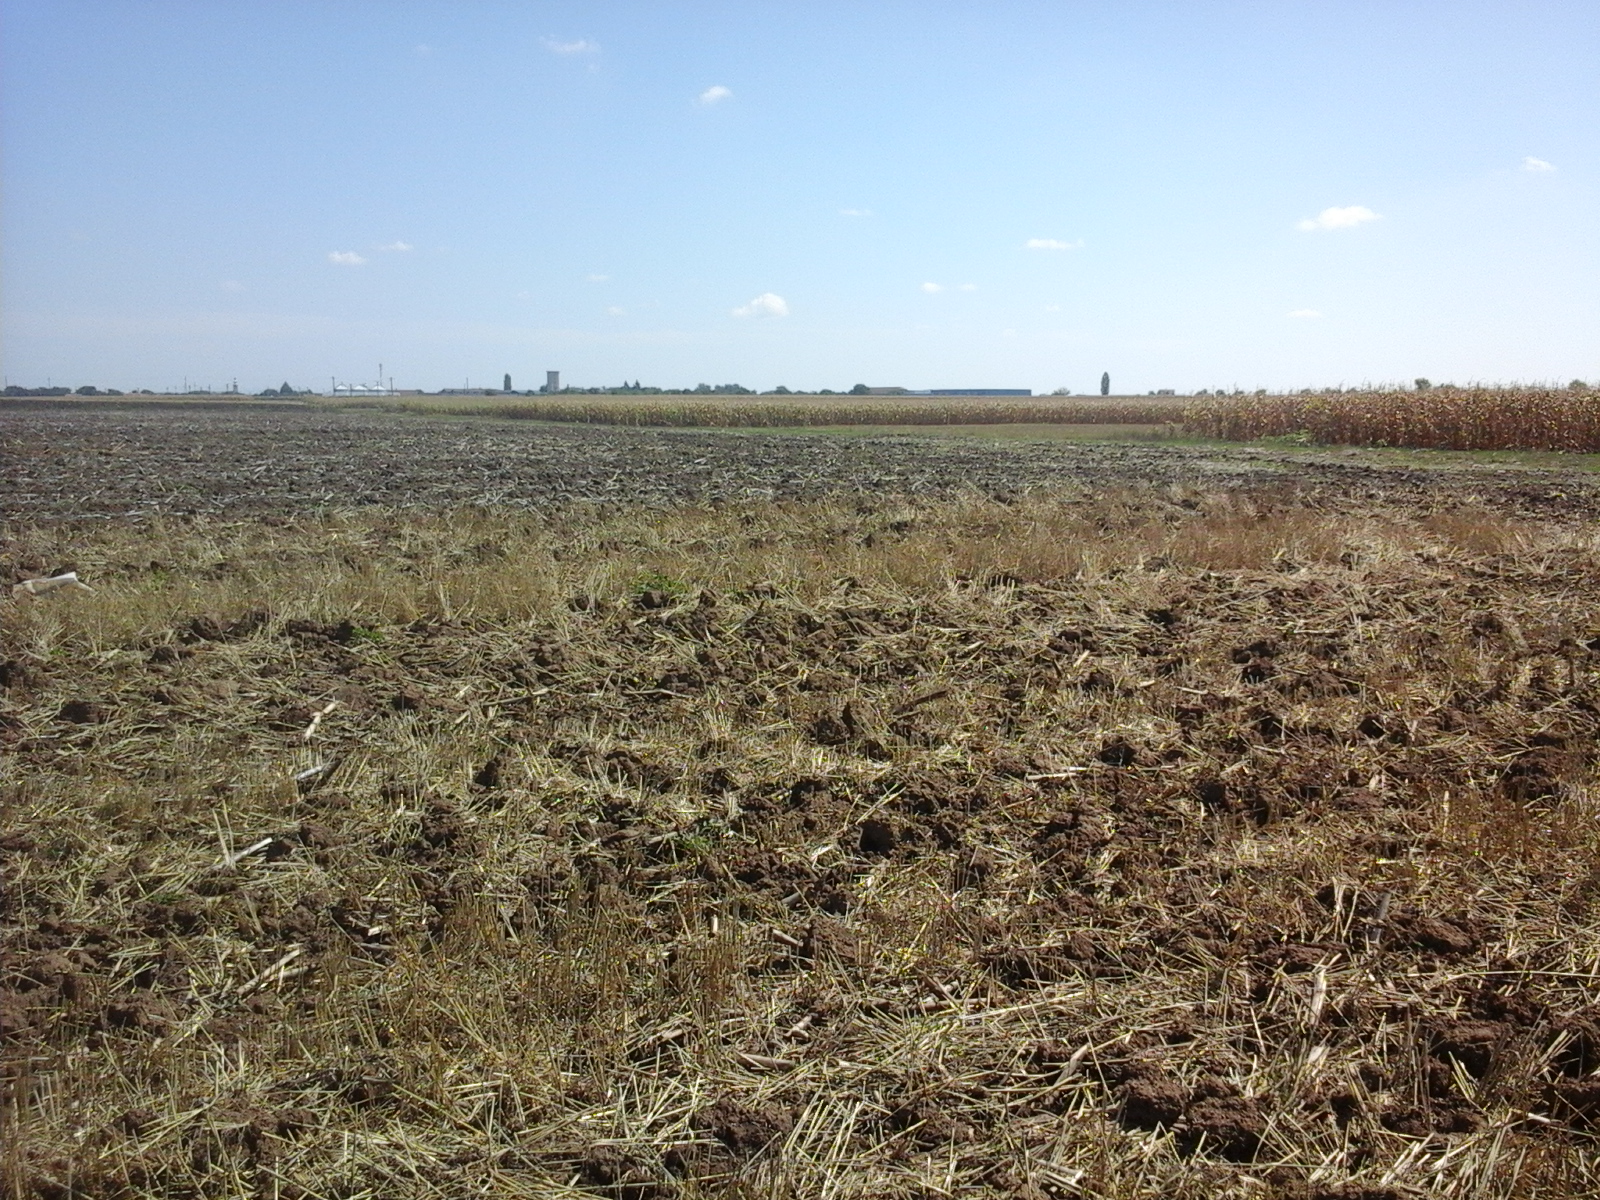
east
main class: Cropland
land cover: Common wheat
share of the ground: 50 - 75 %
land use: Agriculture (excluding fallow land and kitchen gardens)
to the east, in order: Common wheat; Rape and turnip rape; Grass margins; Tracks; Grass margins; Maize; Common wheat; Maize
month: August
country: RO
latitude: 46.1148
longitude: 21.1202
